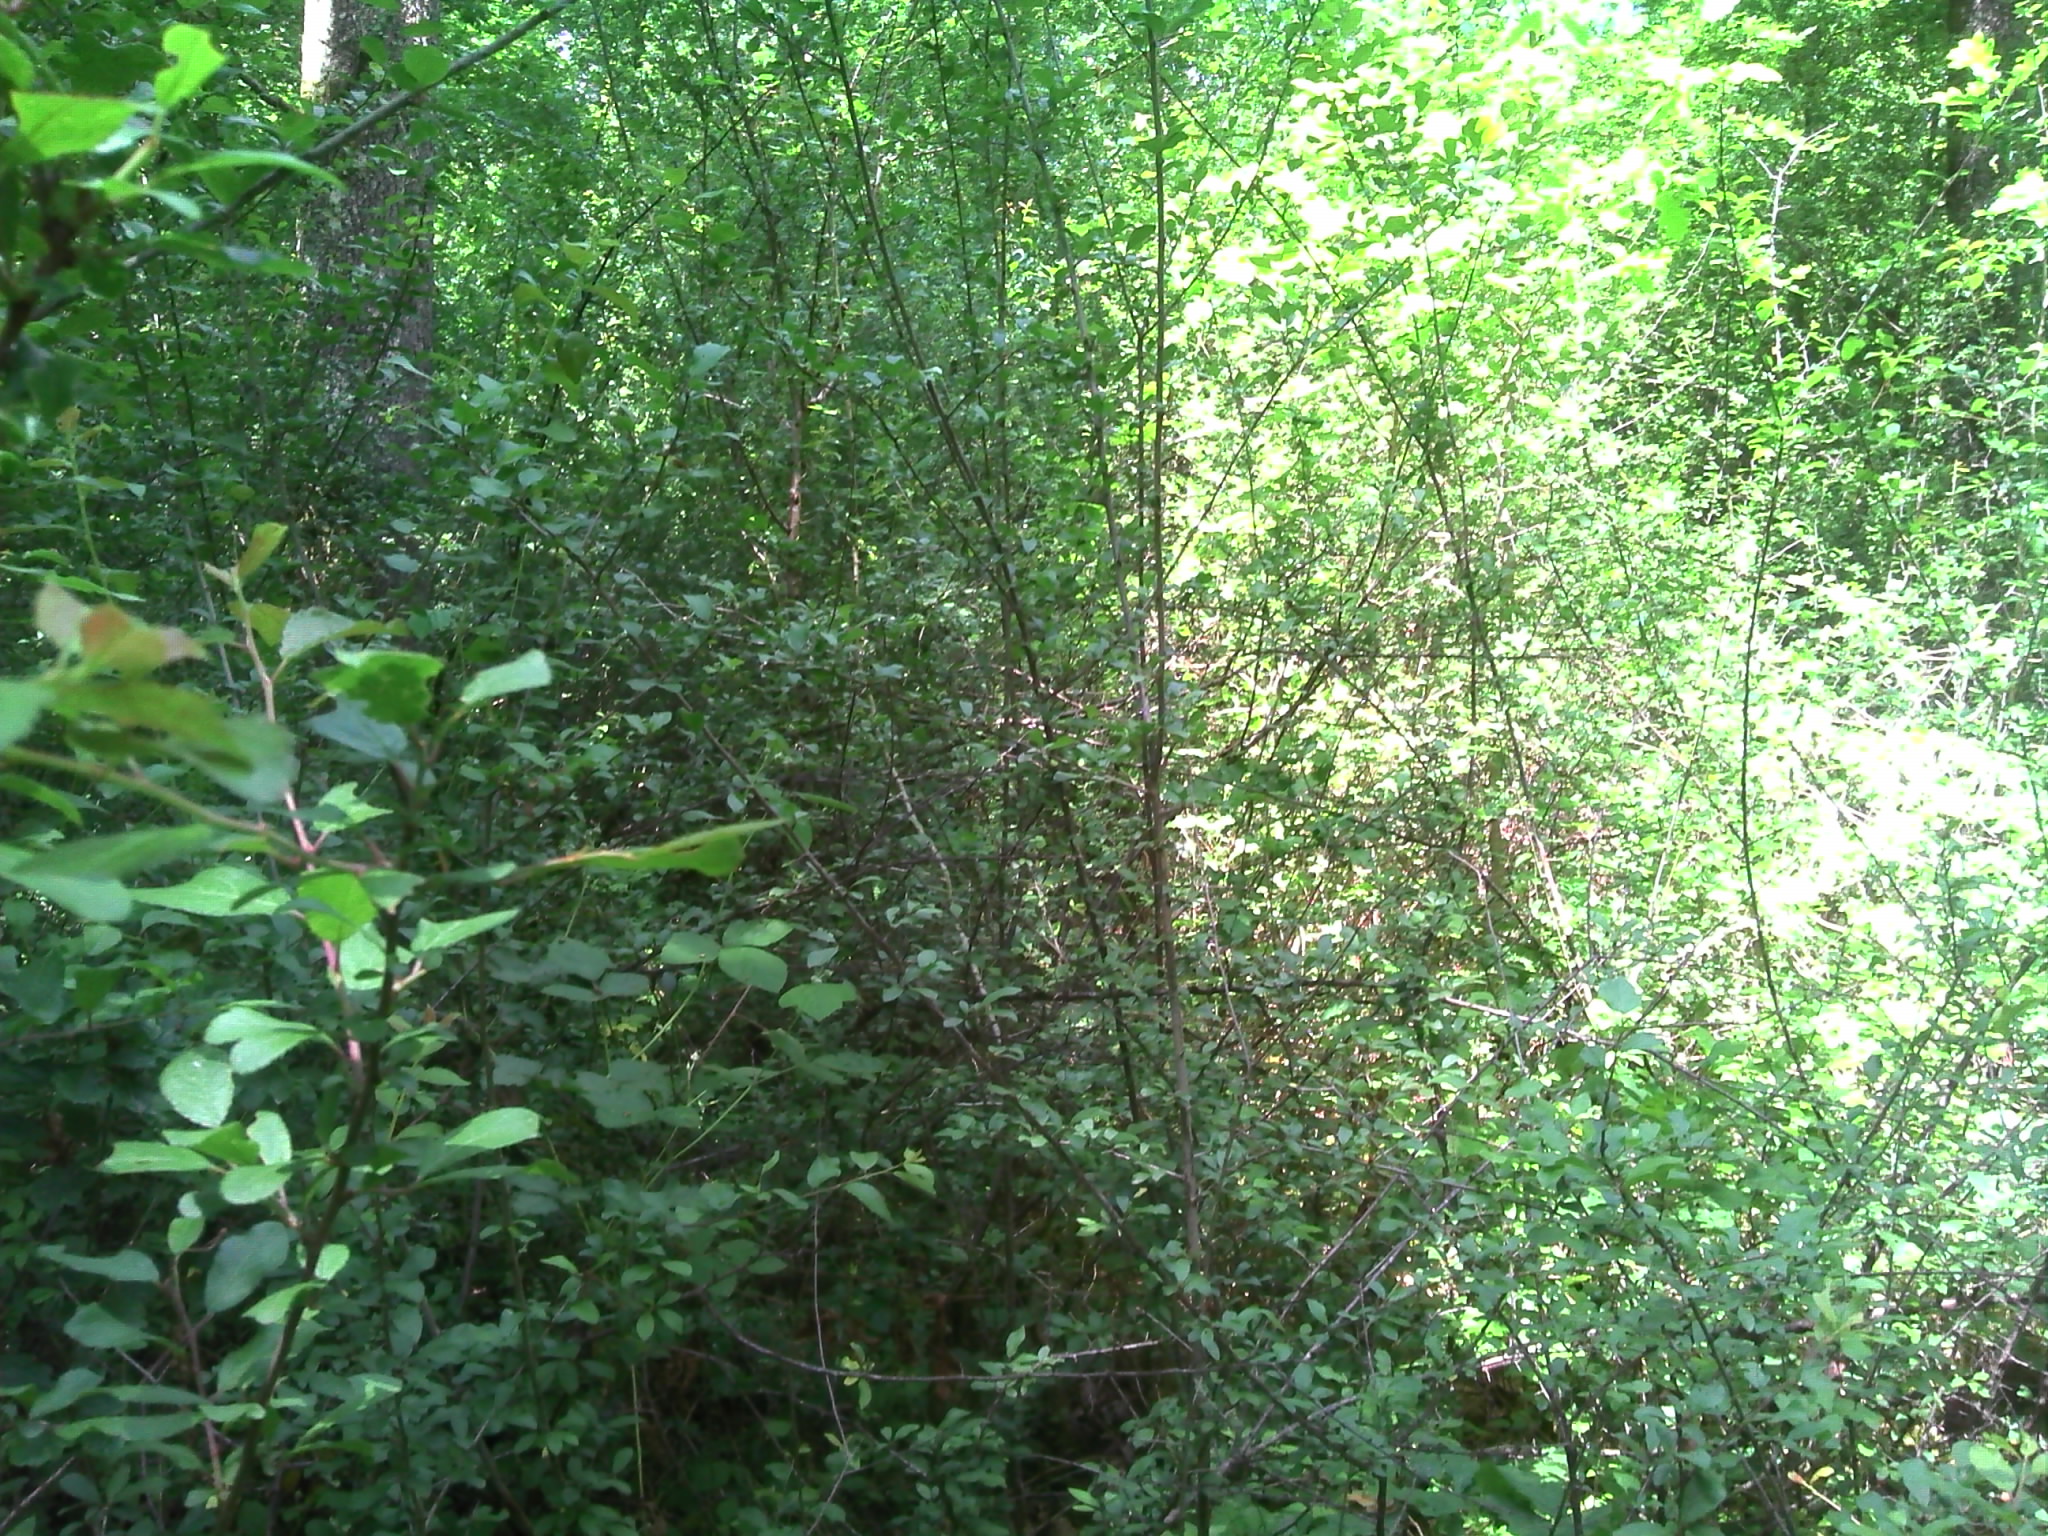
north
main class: Woodland
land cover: Broadleaved woodland
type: mesophytic deciduous forest
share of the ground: > 75 %
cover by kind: broadleaved forest trees 85 %, shrubs 10 %, herbaceous plants 5 %
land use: Forestry
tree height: > 5 m
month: June
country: BE
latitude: 50.2281
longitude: 5.2177
